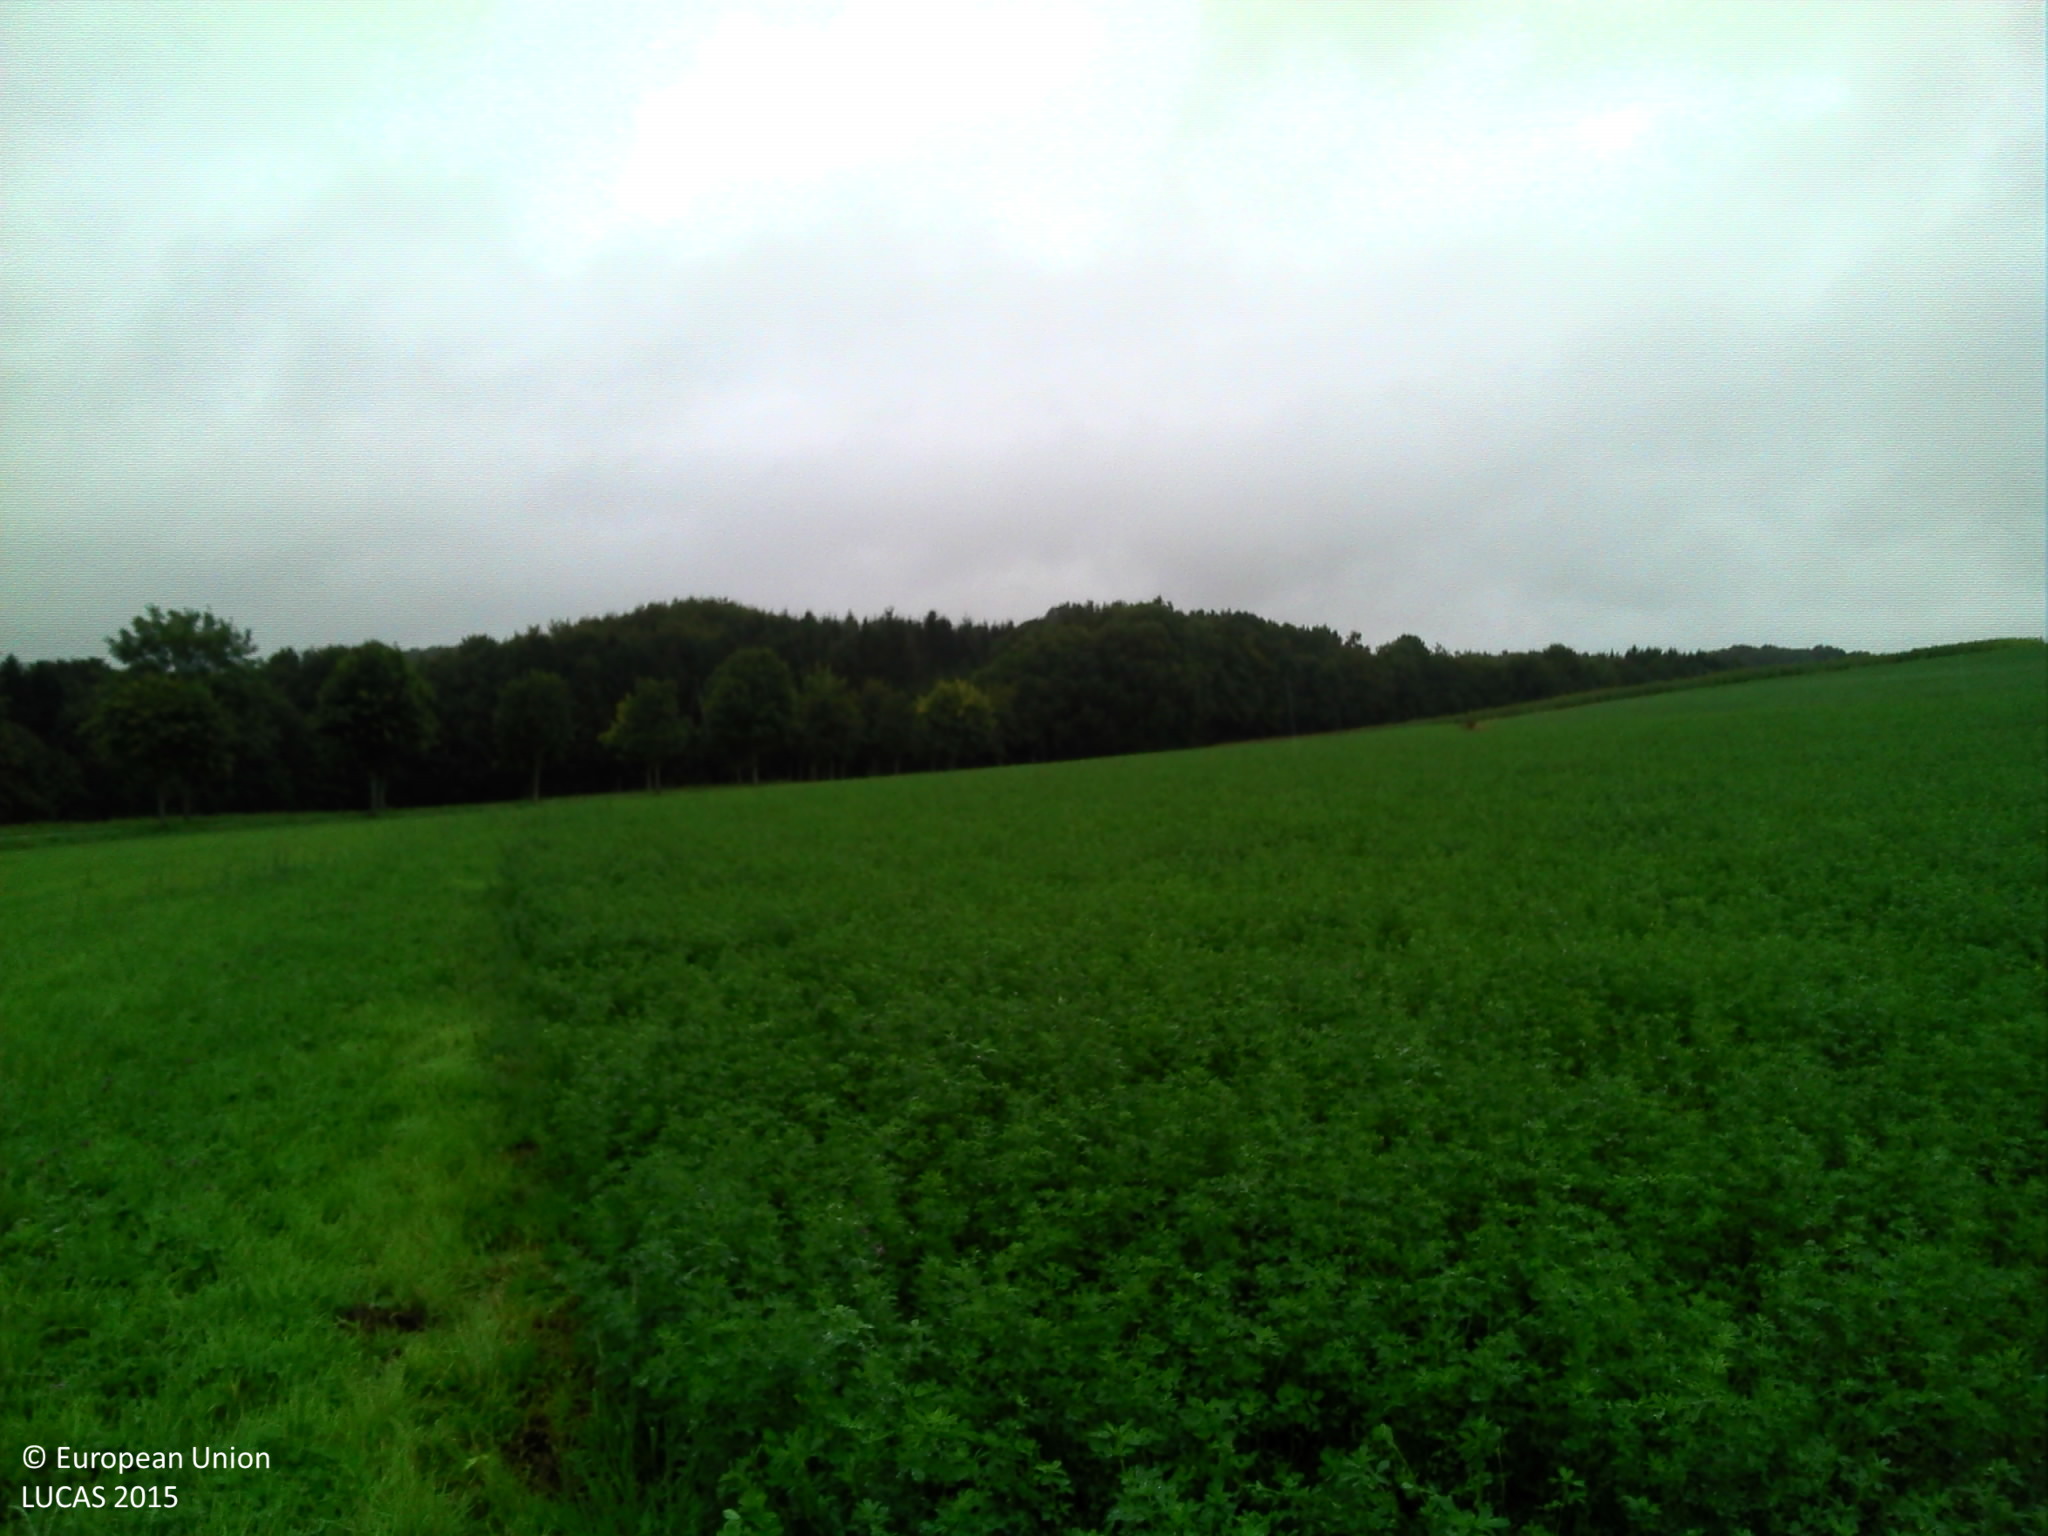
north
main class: Cropland
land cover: Lucerne
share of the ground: > 75 %
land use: Agriculture (excluding fallow land and kitchen gardens)
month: September
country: LU
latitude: 49.7855
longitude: 5.8739
